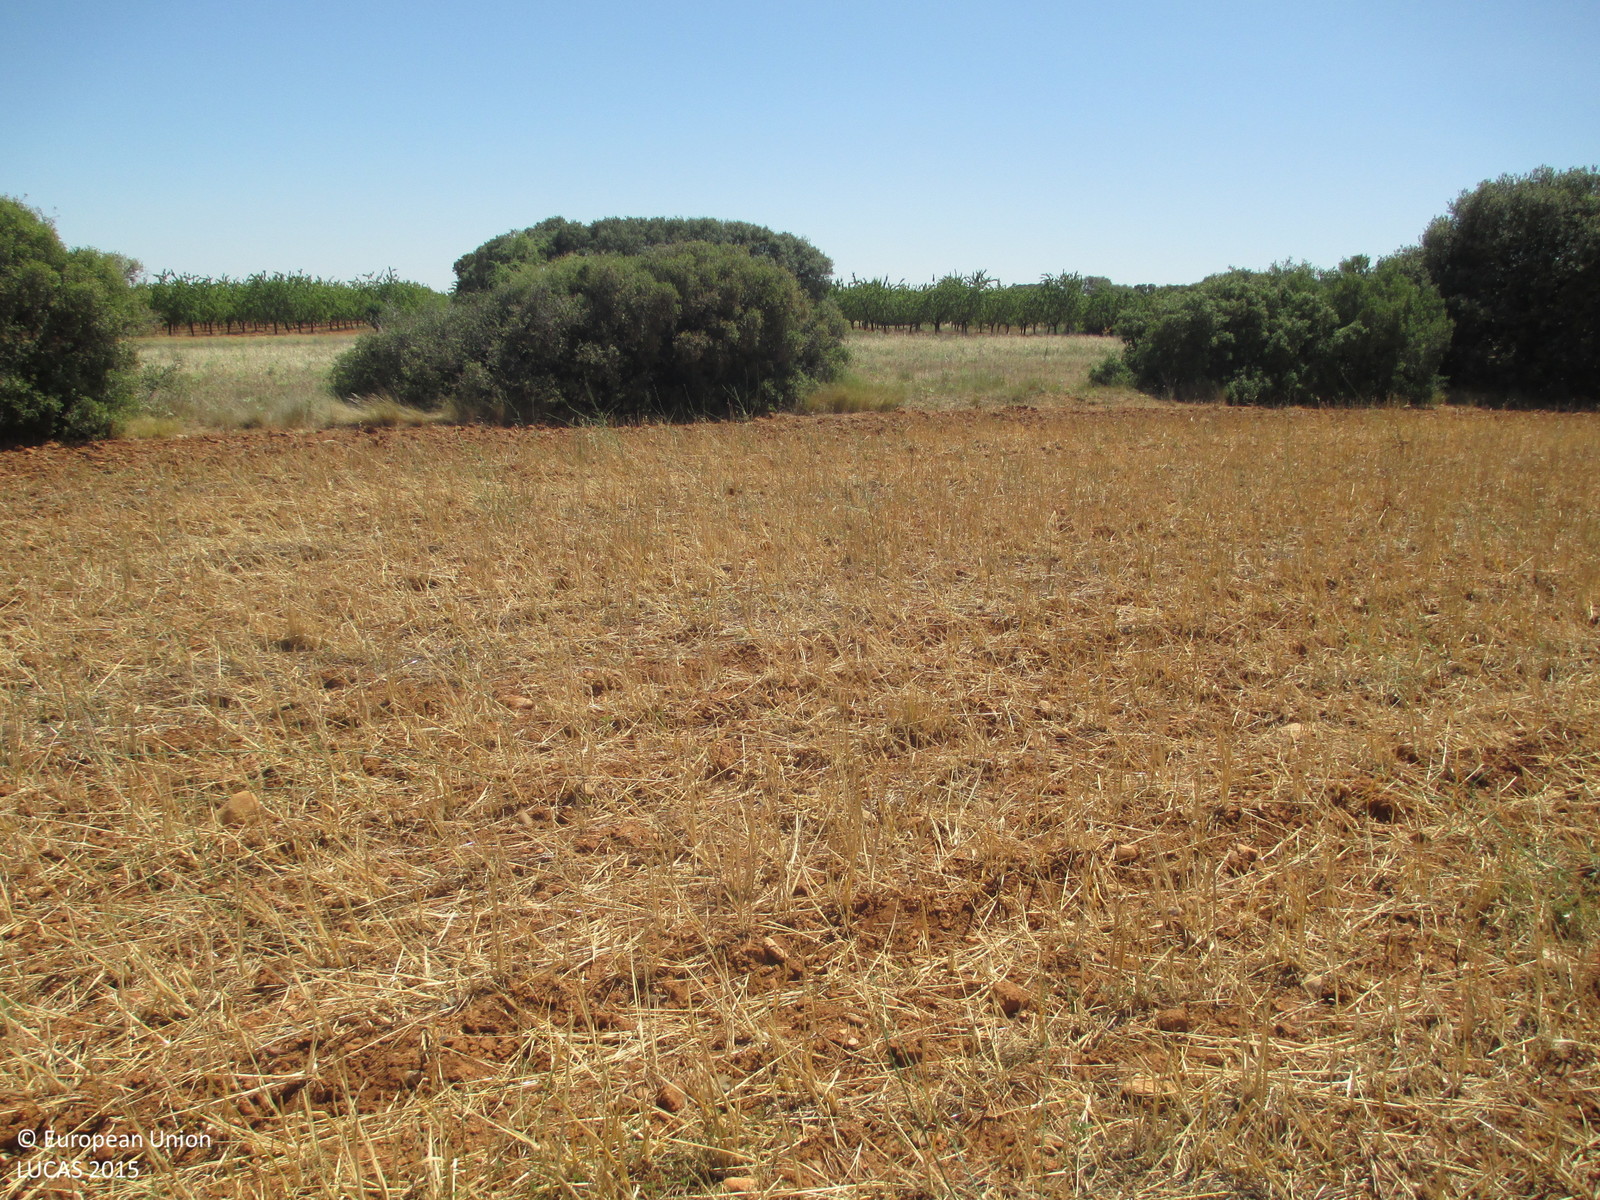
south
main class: Cropland
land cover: Barley
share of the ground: < 10 %
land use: Agriculture (excluding fallow land and kitchen gardens)
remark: Harvested field
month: June
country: ES
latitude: 42.1845
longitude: -0.2774
